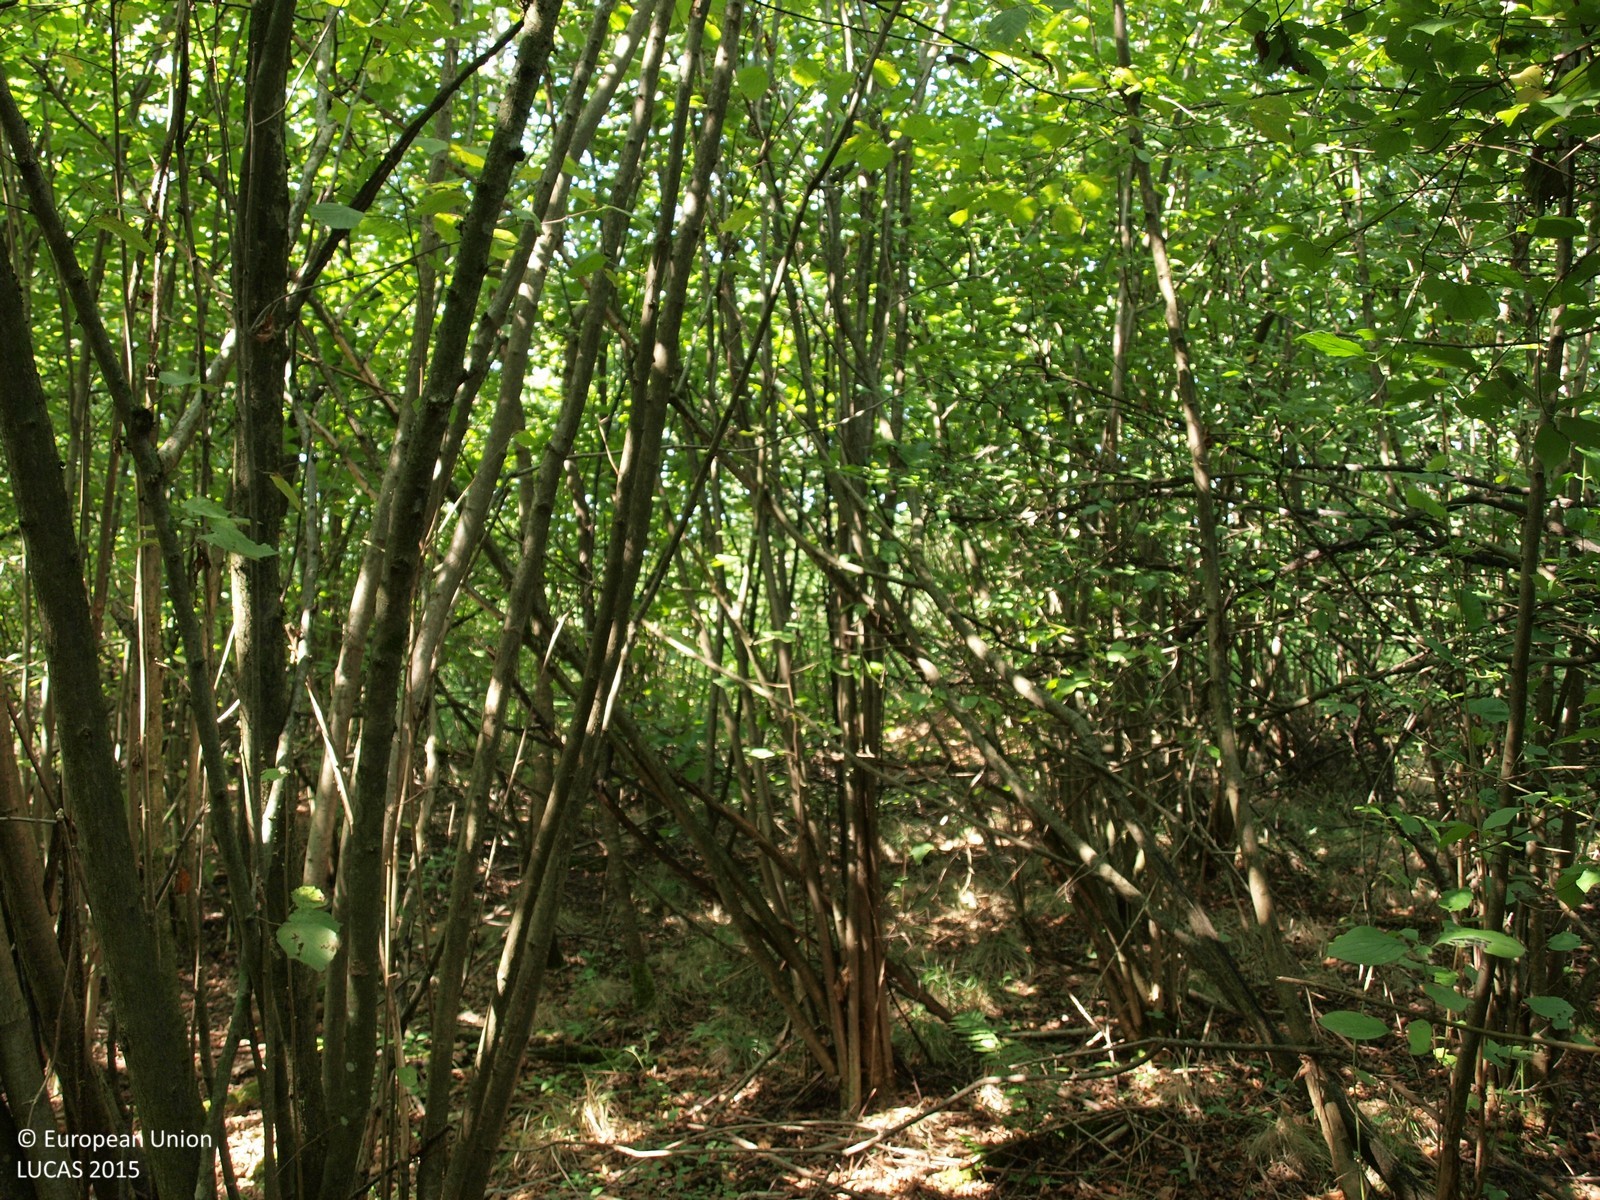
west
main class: Woodland
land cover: Broadleaved woodland
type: mesophytic deciduous forest
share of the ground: > 75 %
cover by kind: broadleaved forest trees 100 %
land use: Forestry
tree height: > 5 m
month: August
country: HR
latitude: 45.6636
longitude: 16.5317
